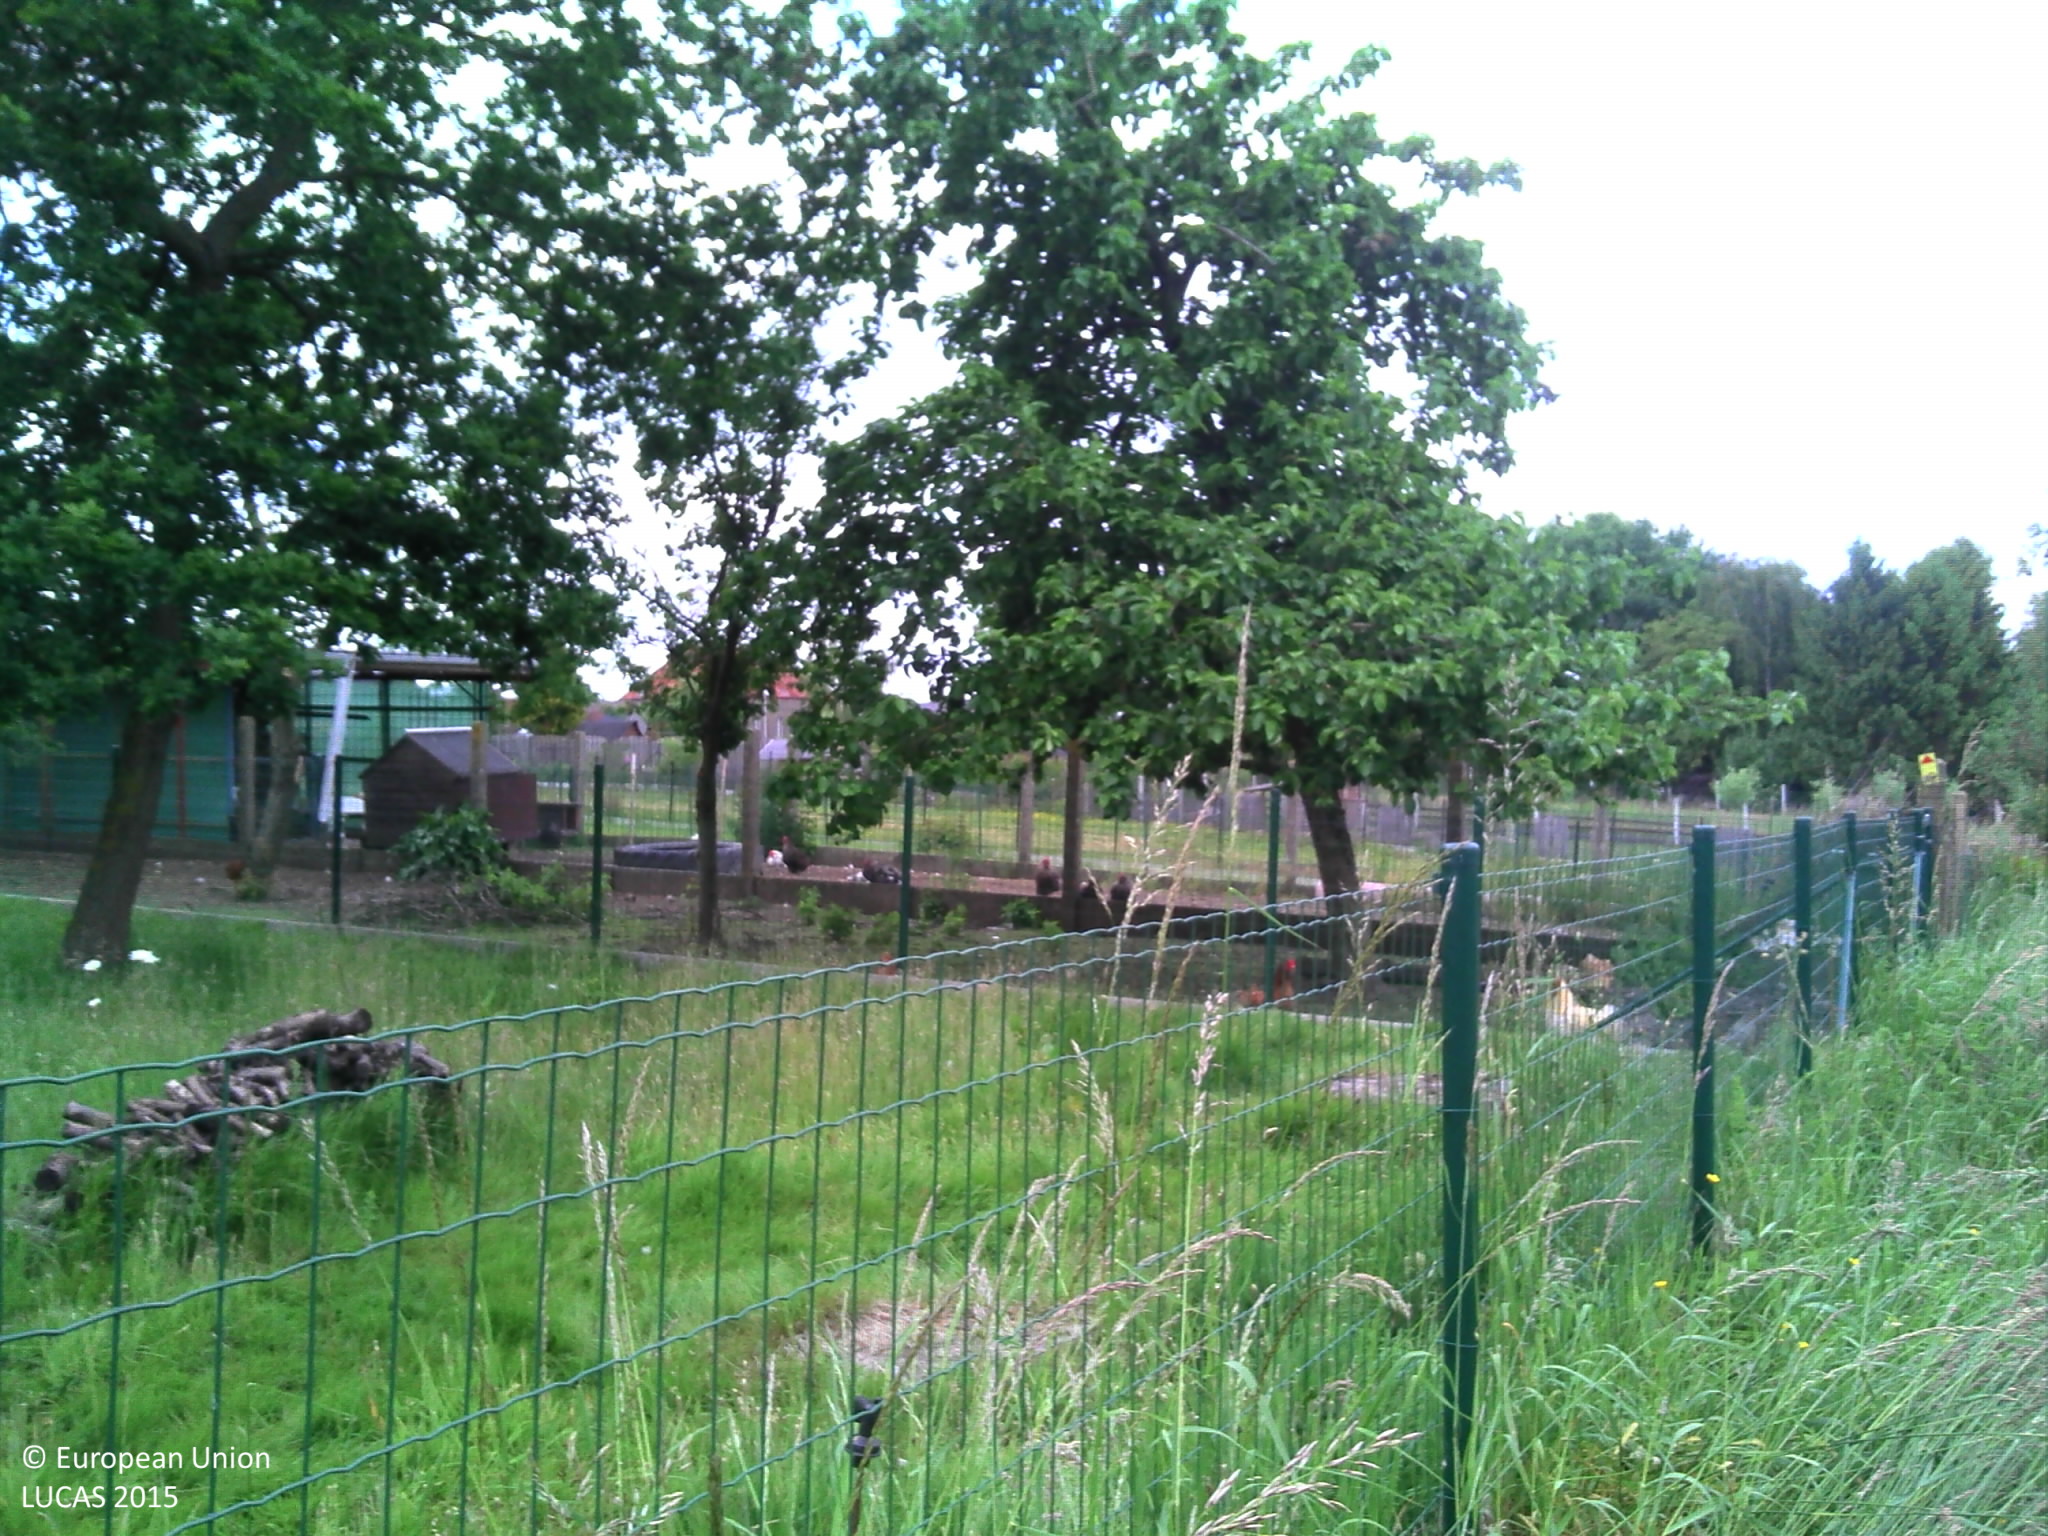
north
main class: Grassland
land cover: Grassland with sparse tree/shrub cover
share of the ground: > 75 %
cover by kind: herbaceous plants 95 %, broadleaved forest trees 5 %
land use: Residential
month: June
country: BE
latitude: 50.7594
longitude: 3.8837
